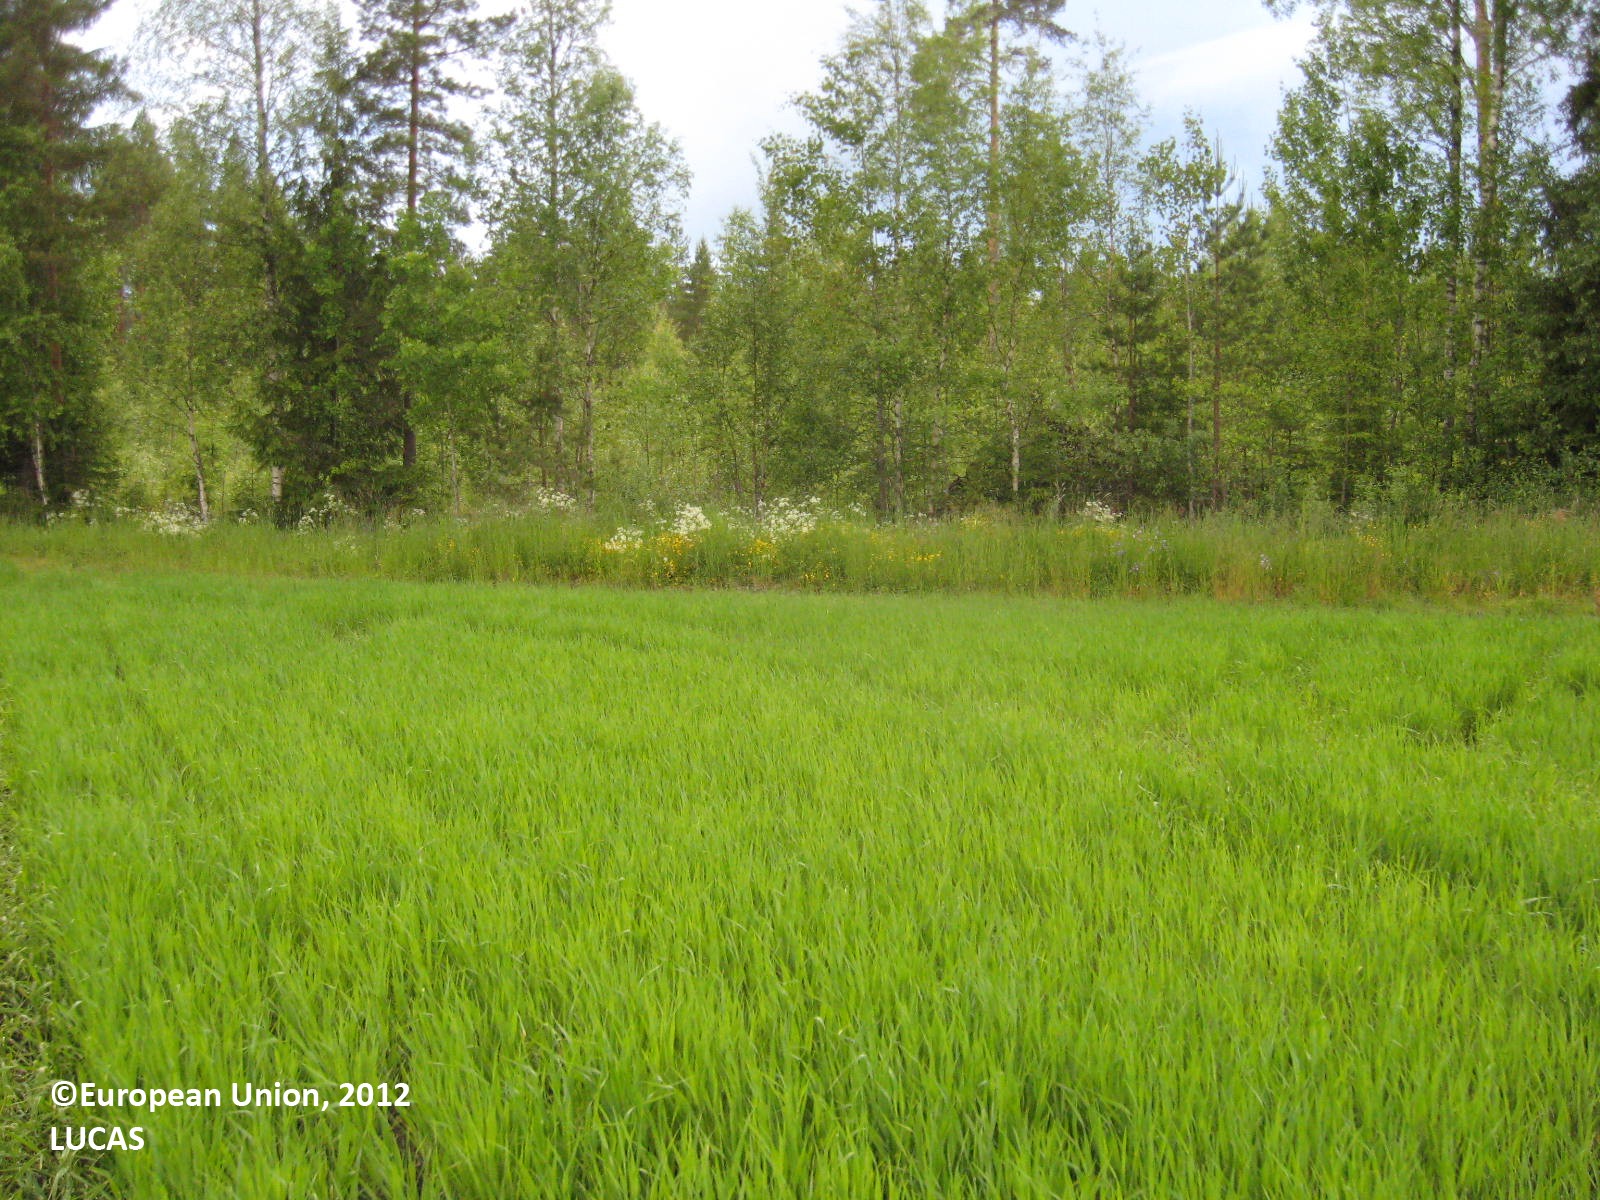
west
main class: Cropland
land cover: Barley
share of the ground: > 75 %
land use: Agriculture (excluding fallow land and kitchen gardens)
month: June
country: FI
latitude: 62.9406
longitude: 22.6047
